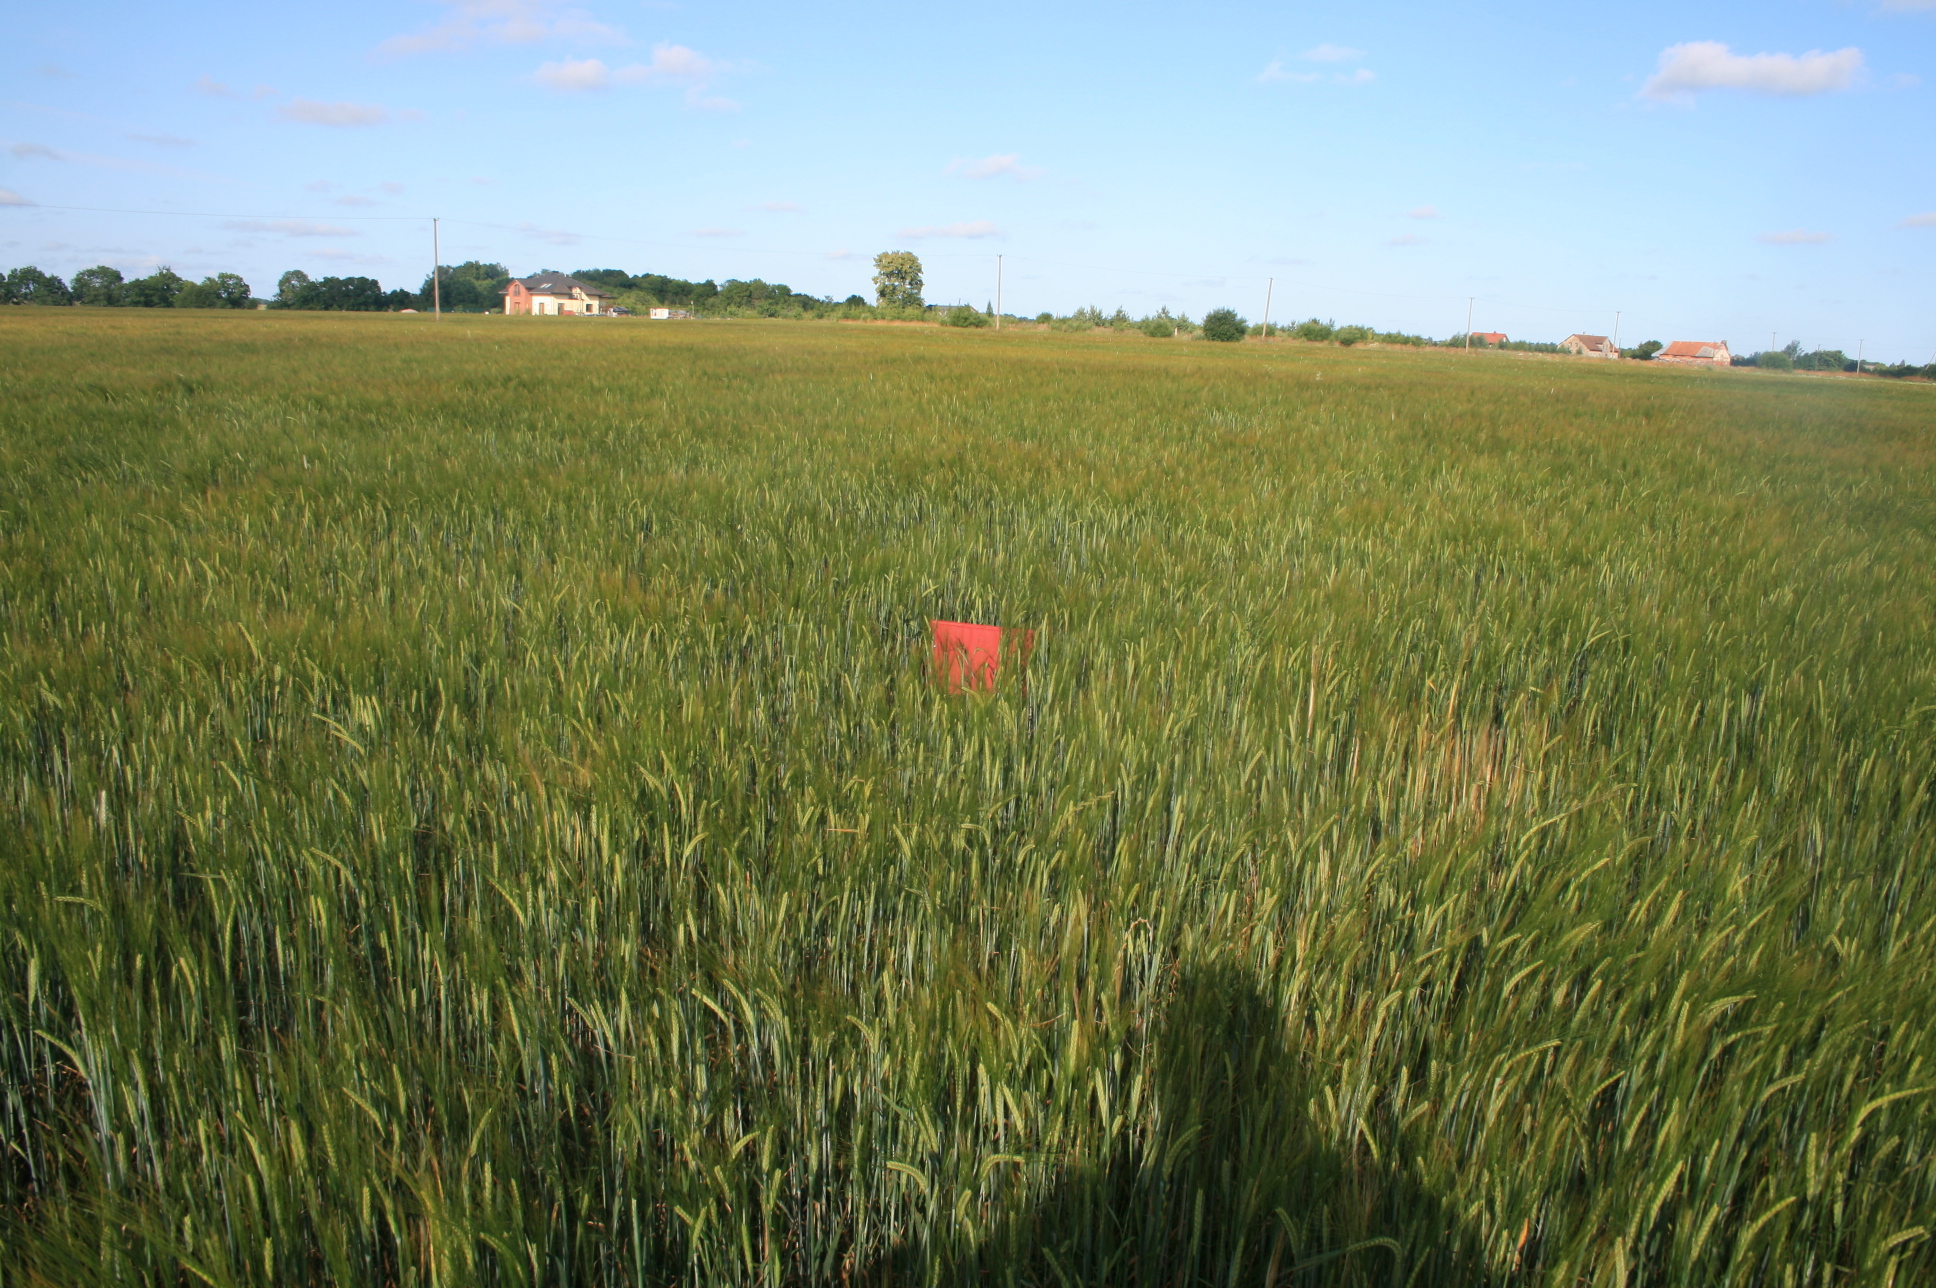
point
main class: Cropland
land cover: Barley
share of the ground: > 75 %
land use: Agriculture (excluding fallow land and kitchen gardens)
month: July
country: LT
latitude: 55.8381
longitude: 21.2346
